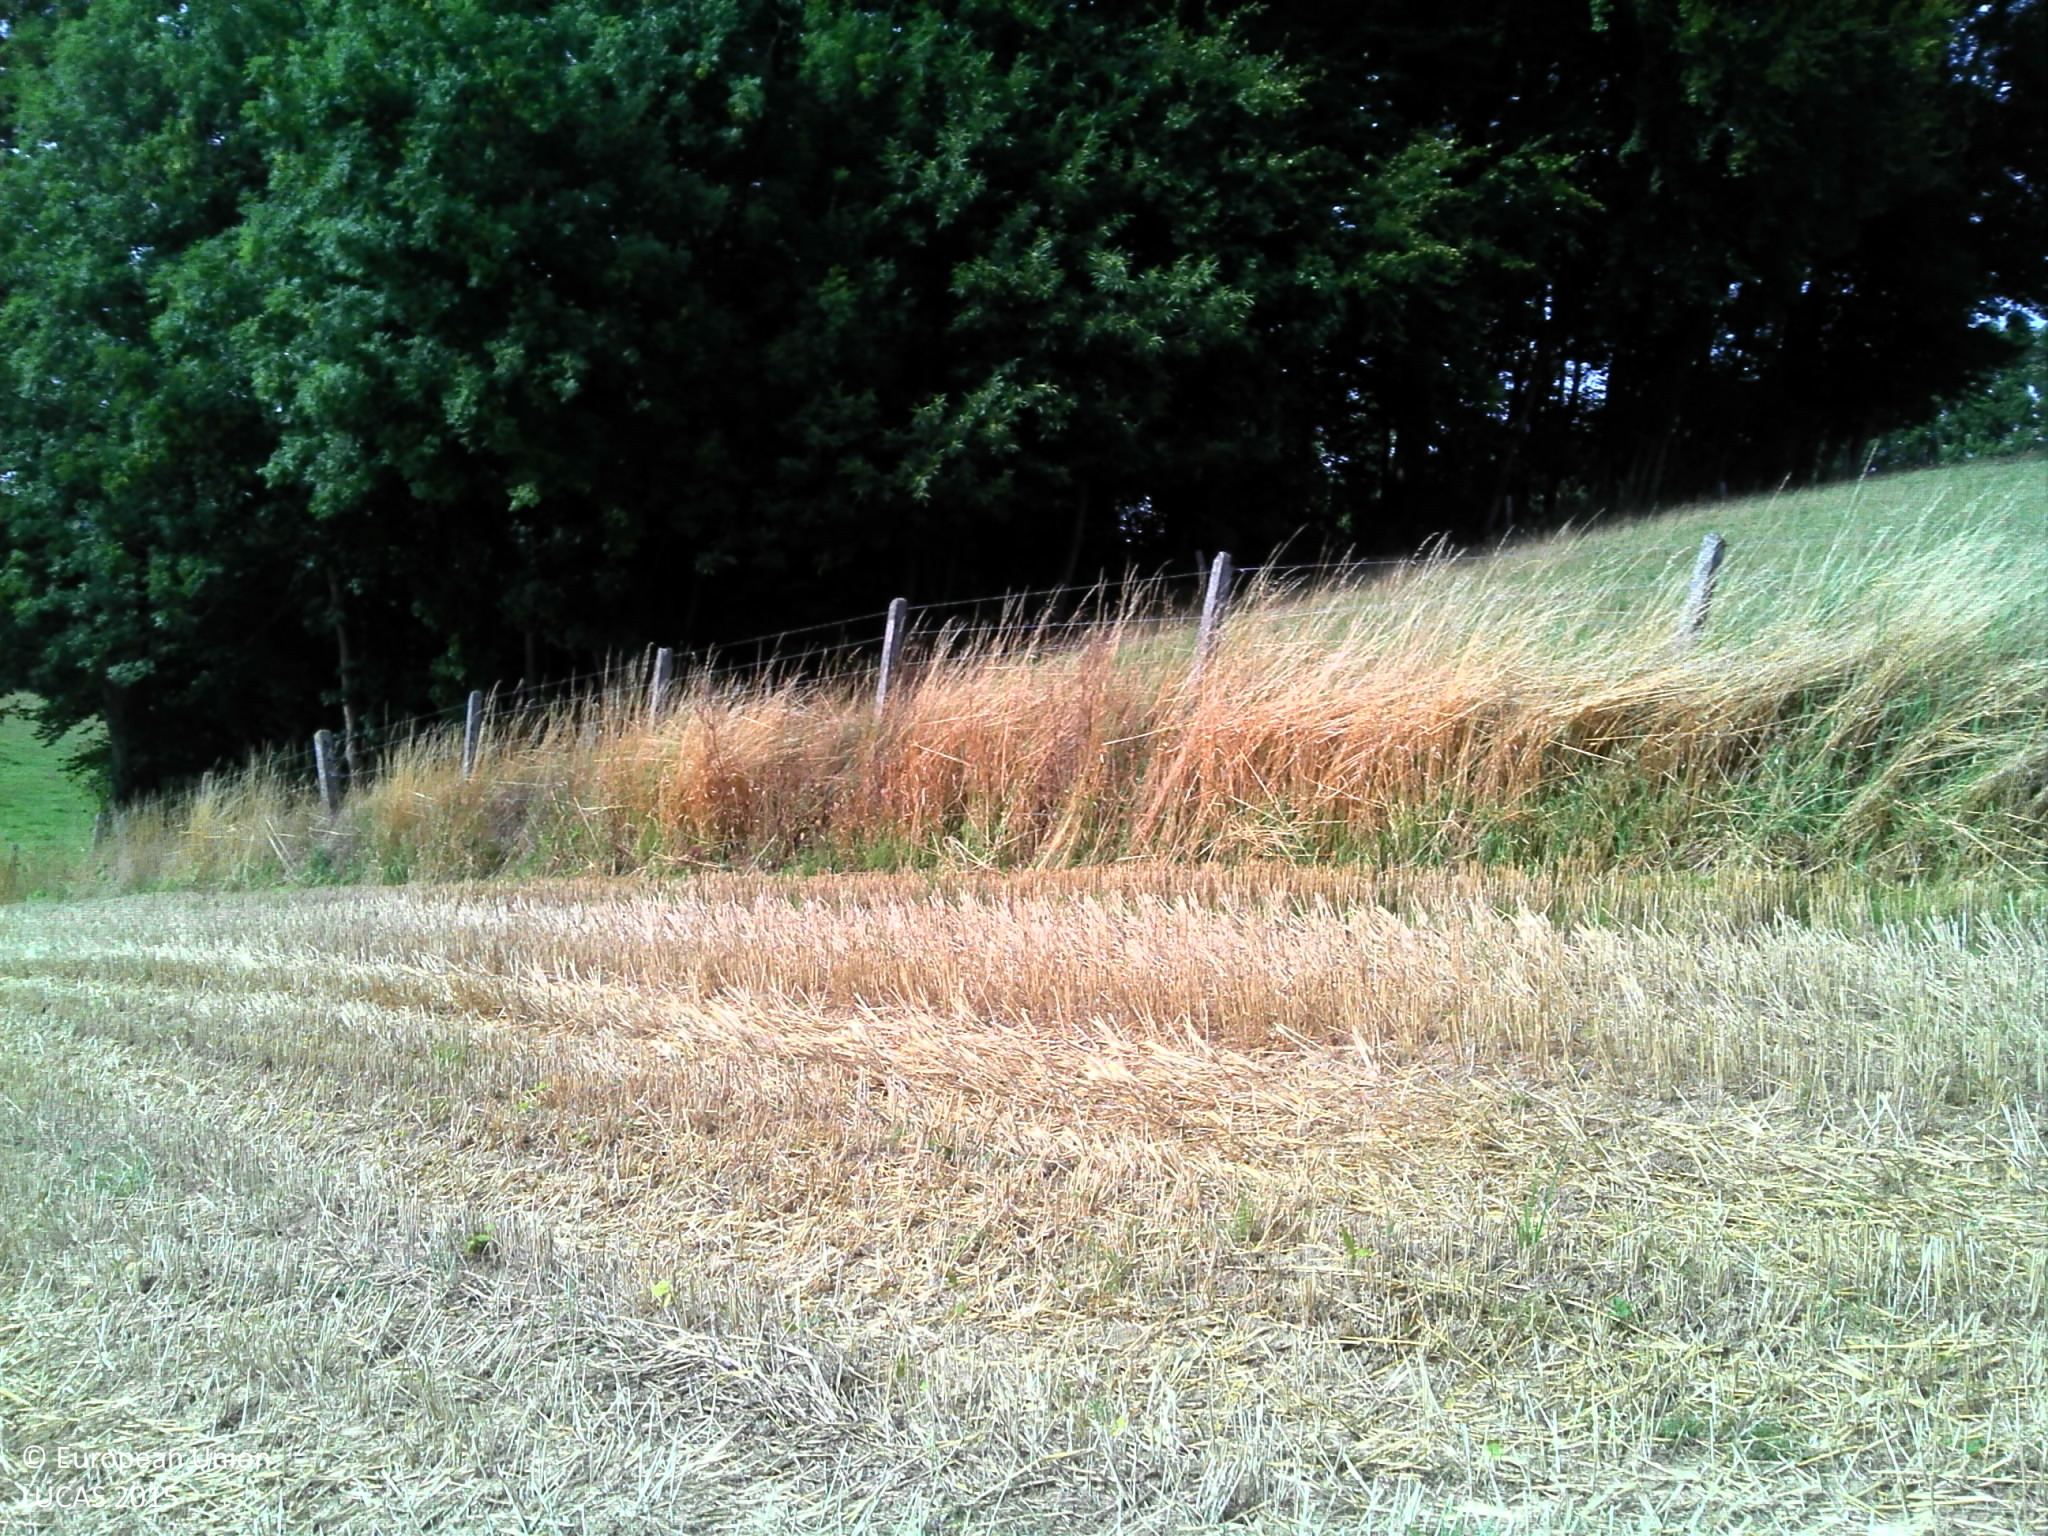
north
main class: Cropland
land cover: Common wheat
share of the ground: > 75 %
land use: Agriculture (excluding fallow land and kitchen gardens)
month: August
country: BE
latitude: 50.7129
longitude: 3.6908
